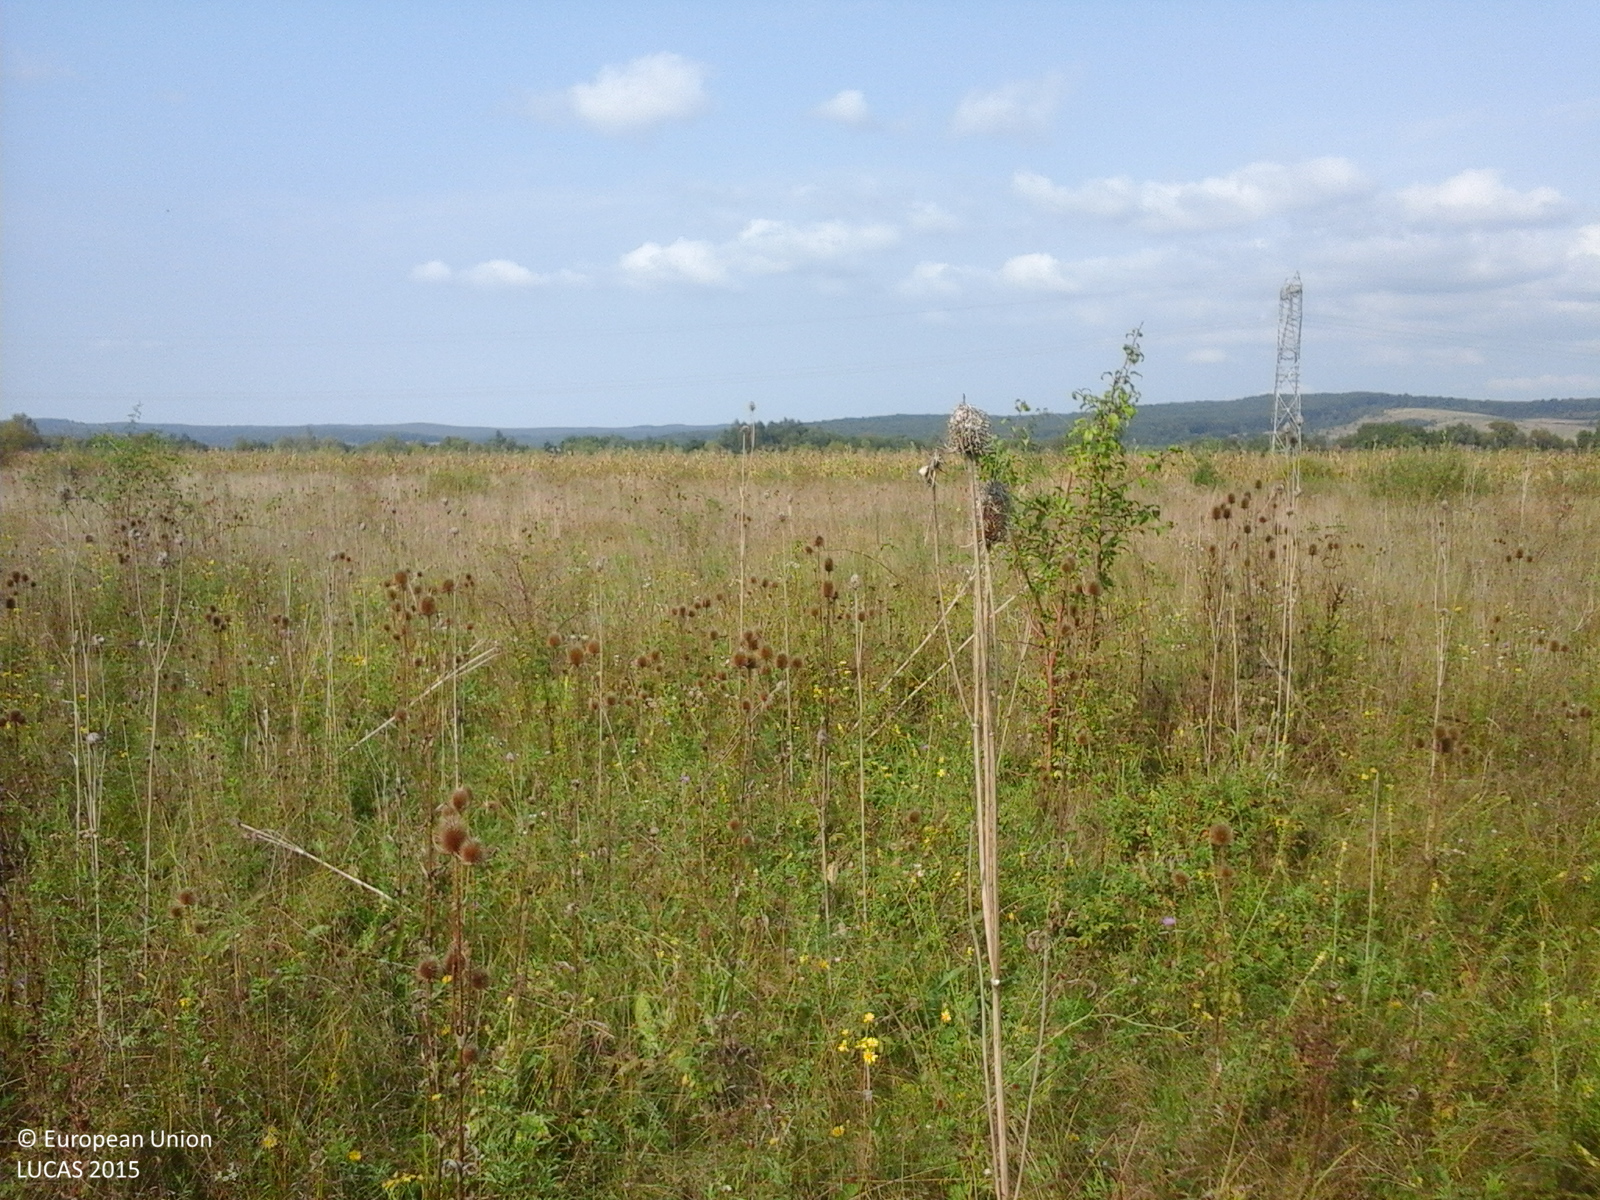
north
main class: Grassland
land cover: Spontaneously vegetated surfaces
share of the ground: > 75 %
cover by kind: herbaceous plants 100 %
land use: Fallow land
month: September
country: RO
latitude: 45.8398
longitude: 22.2889
